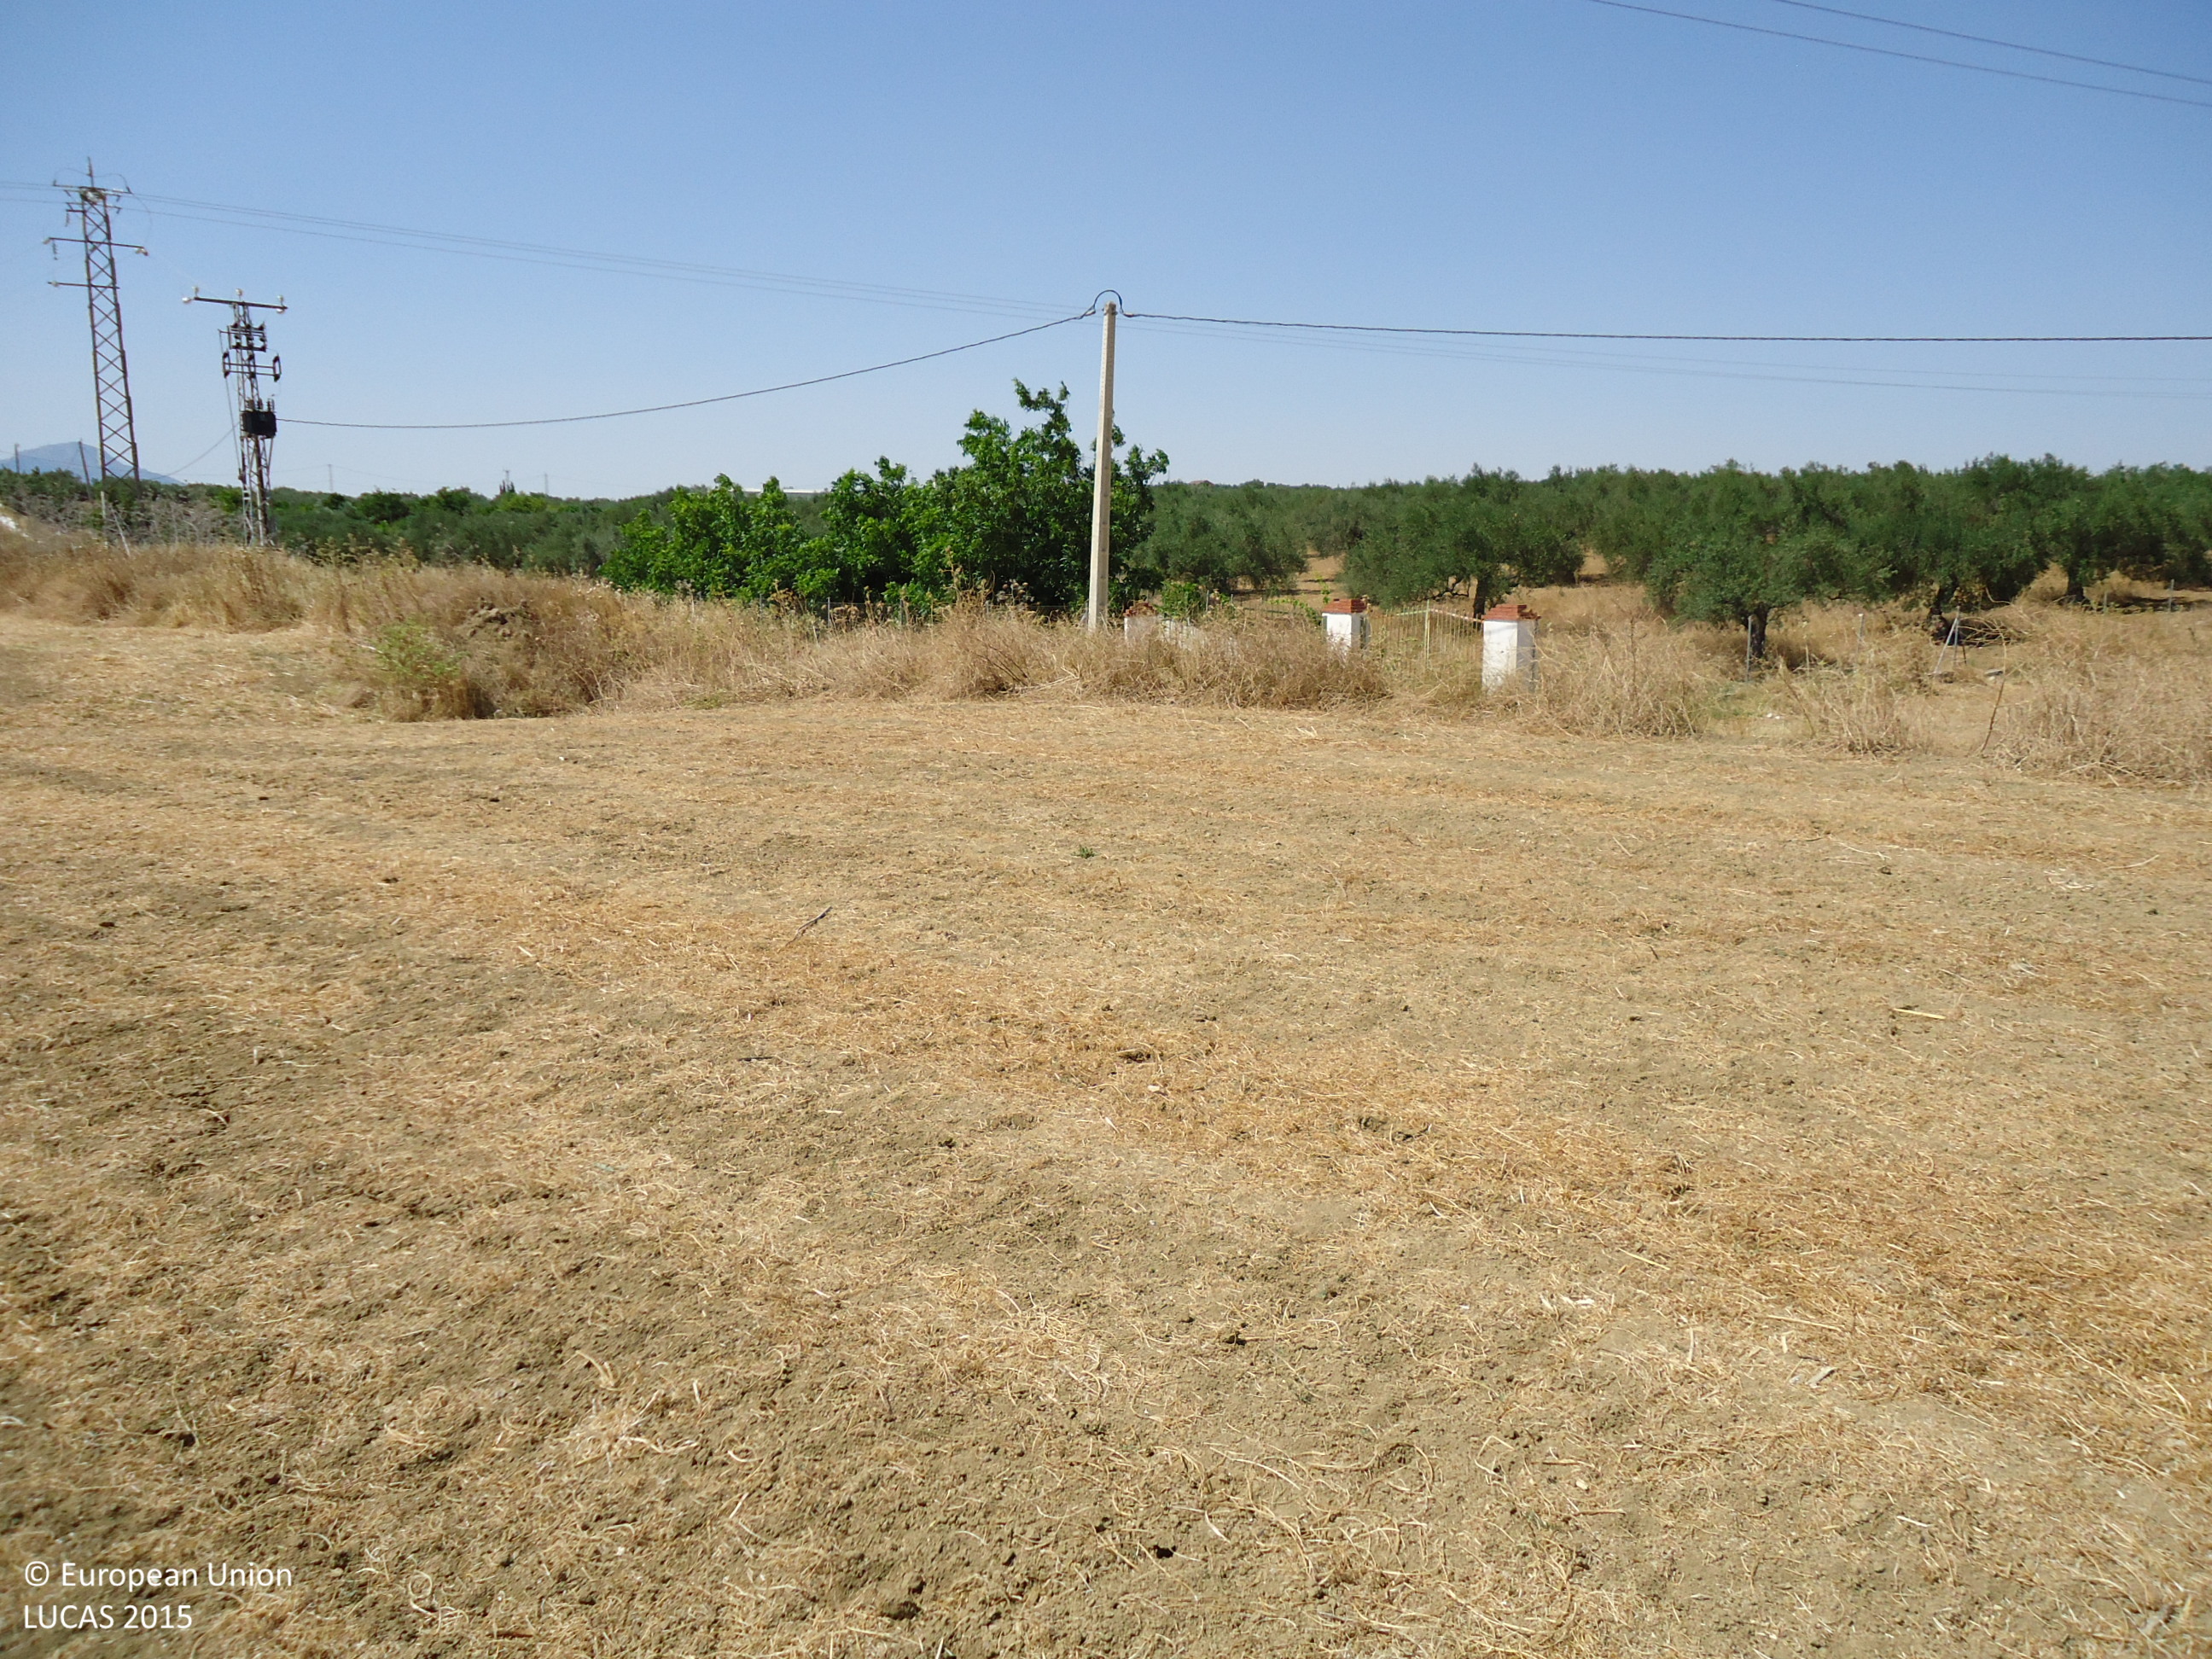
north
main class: Grassland
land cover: Spontaneously vegetated surfaces
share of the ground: > 75 %
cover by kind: herbaceous plants 90 %, unconsolidated bare surface 10 %
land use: Agriculture (excluding fallow land and kitchen gardens)
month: June
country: ES
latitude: 36.6854
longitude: -4.7314
